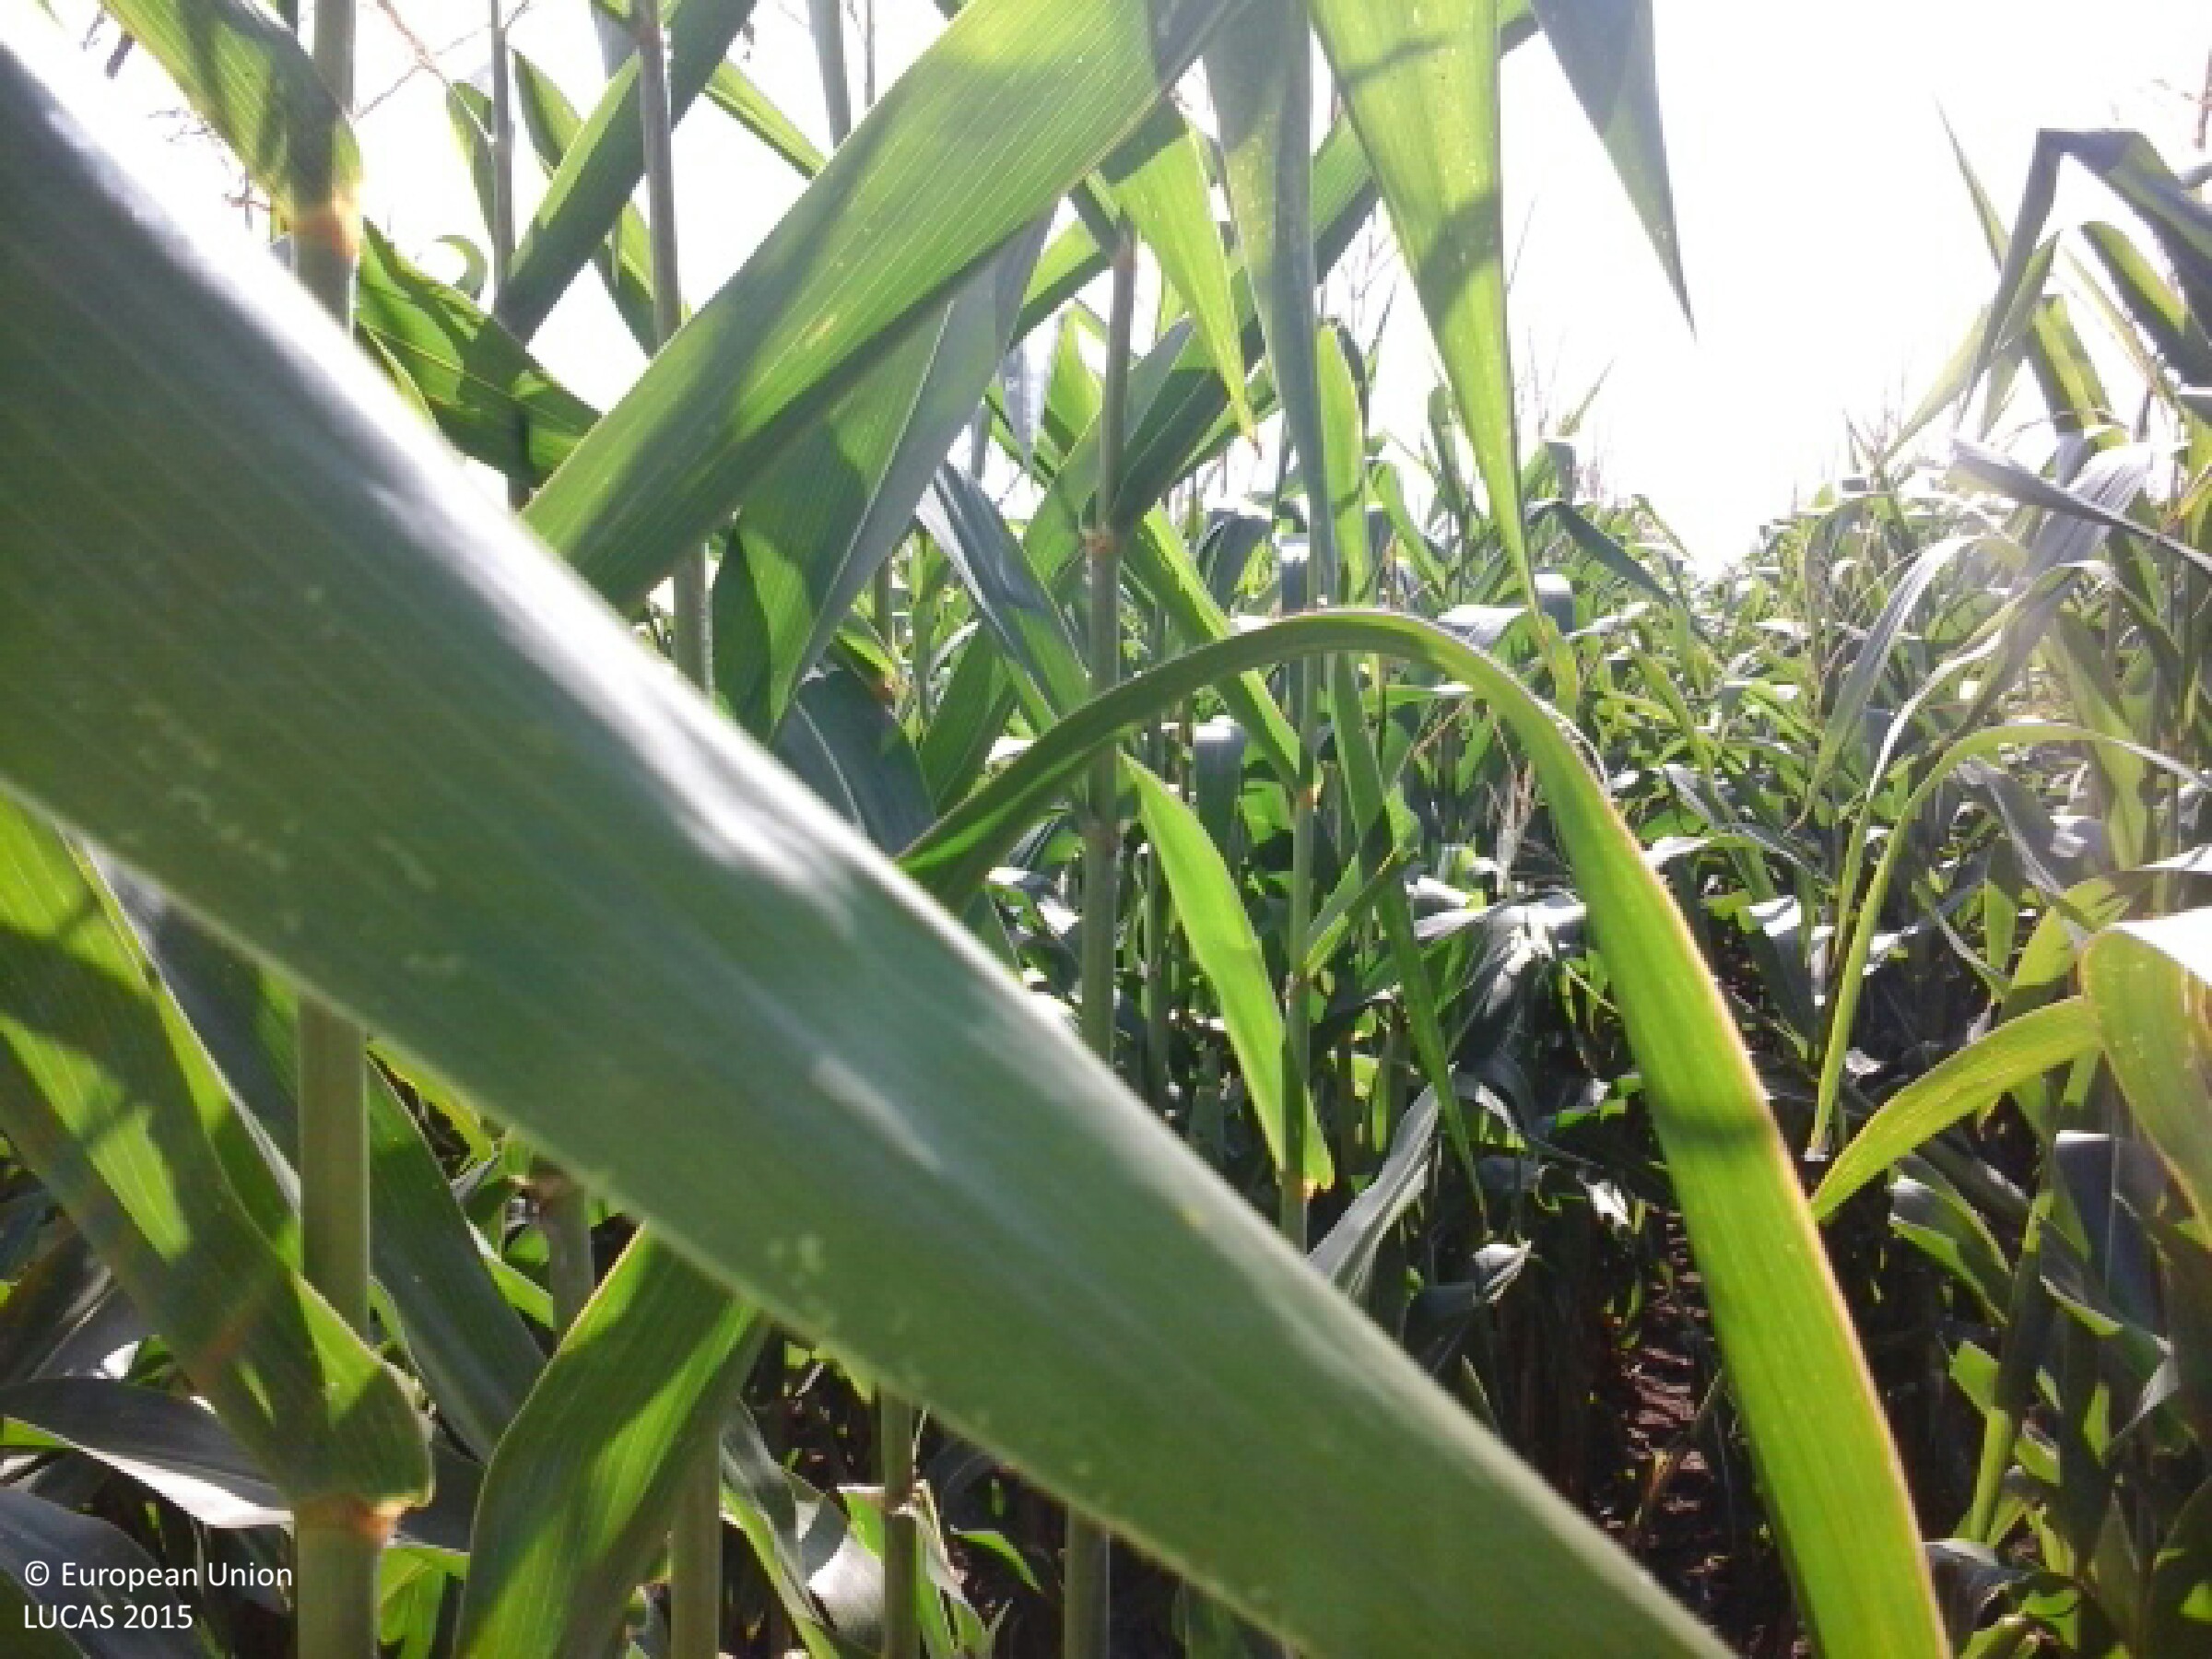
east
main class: Cropland
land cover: Maize
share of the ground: > 75 %
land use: Agriculture (excluding fallow land and kitchen gardens)
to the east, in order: Maize
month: August
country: HU
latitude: 47.6022
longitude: 18.5404
